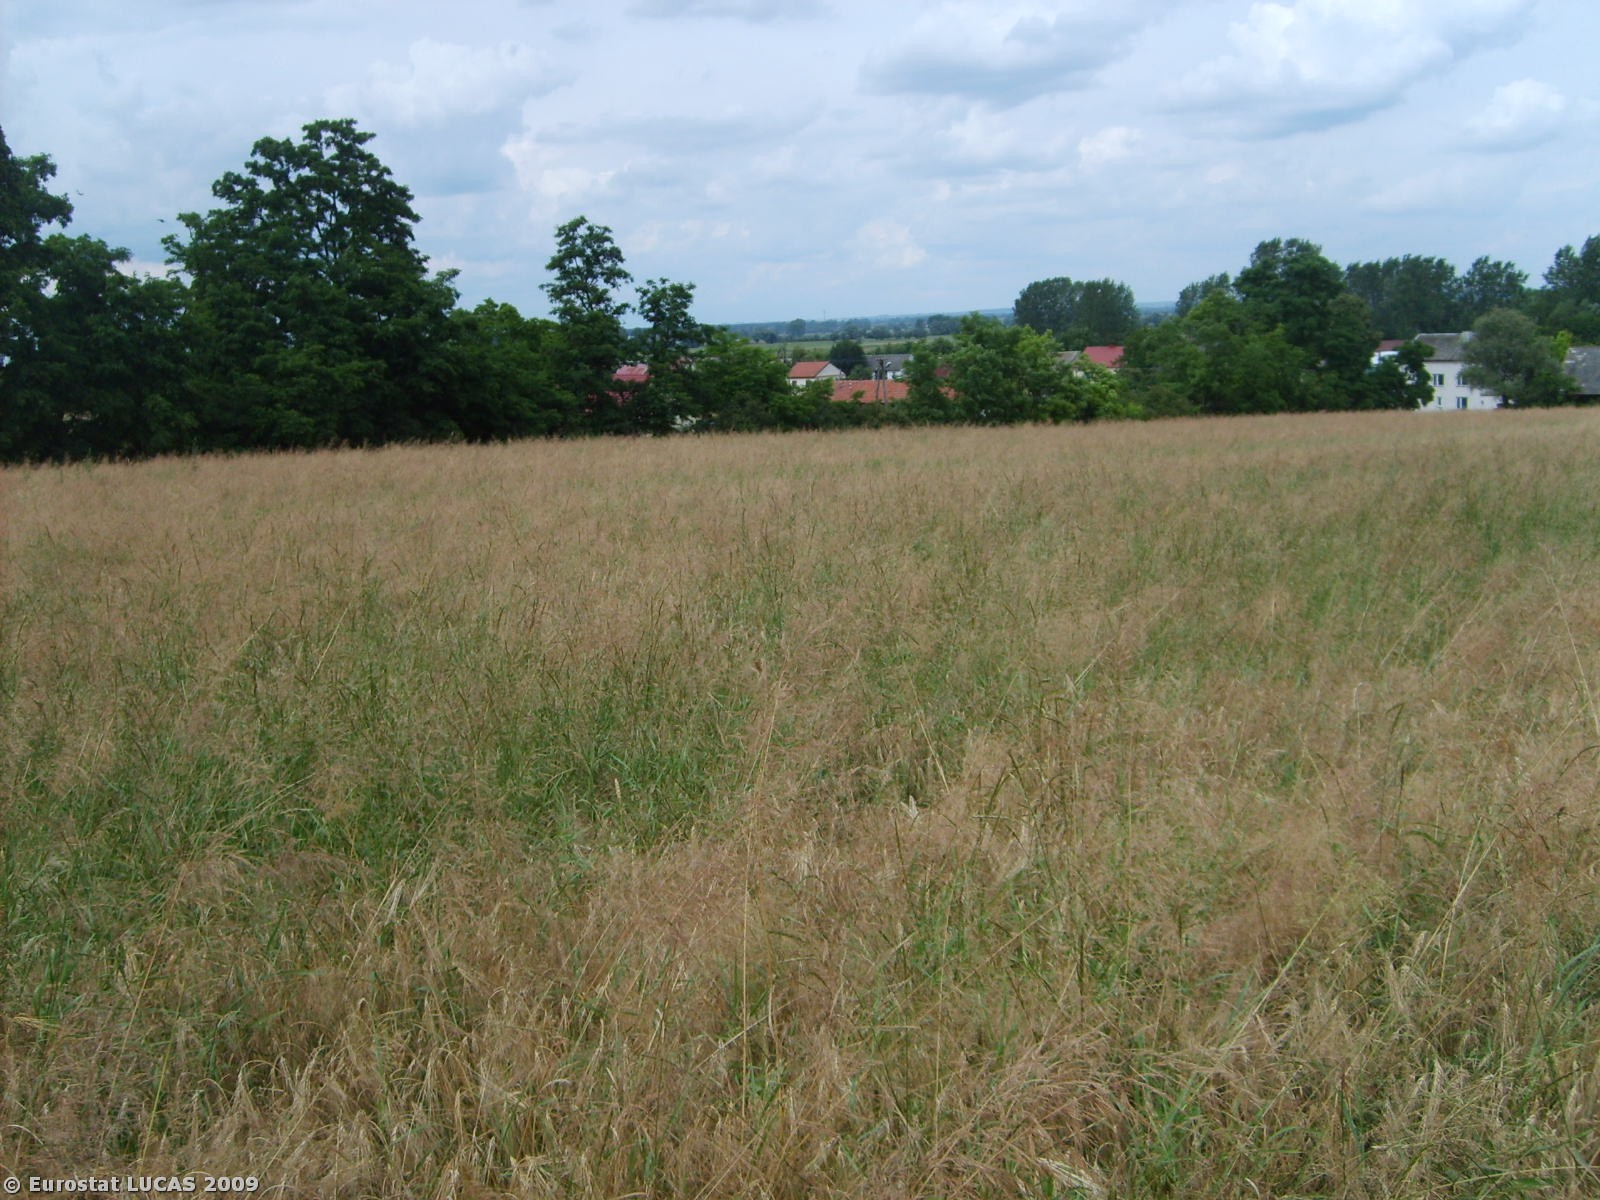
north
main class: Cropland
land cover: Barley
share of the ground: > 75 %
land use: Agriculture (excluding fallow land and kitchen gardens)
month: July
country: PL
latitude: 50.3169
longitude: 20.6711
